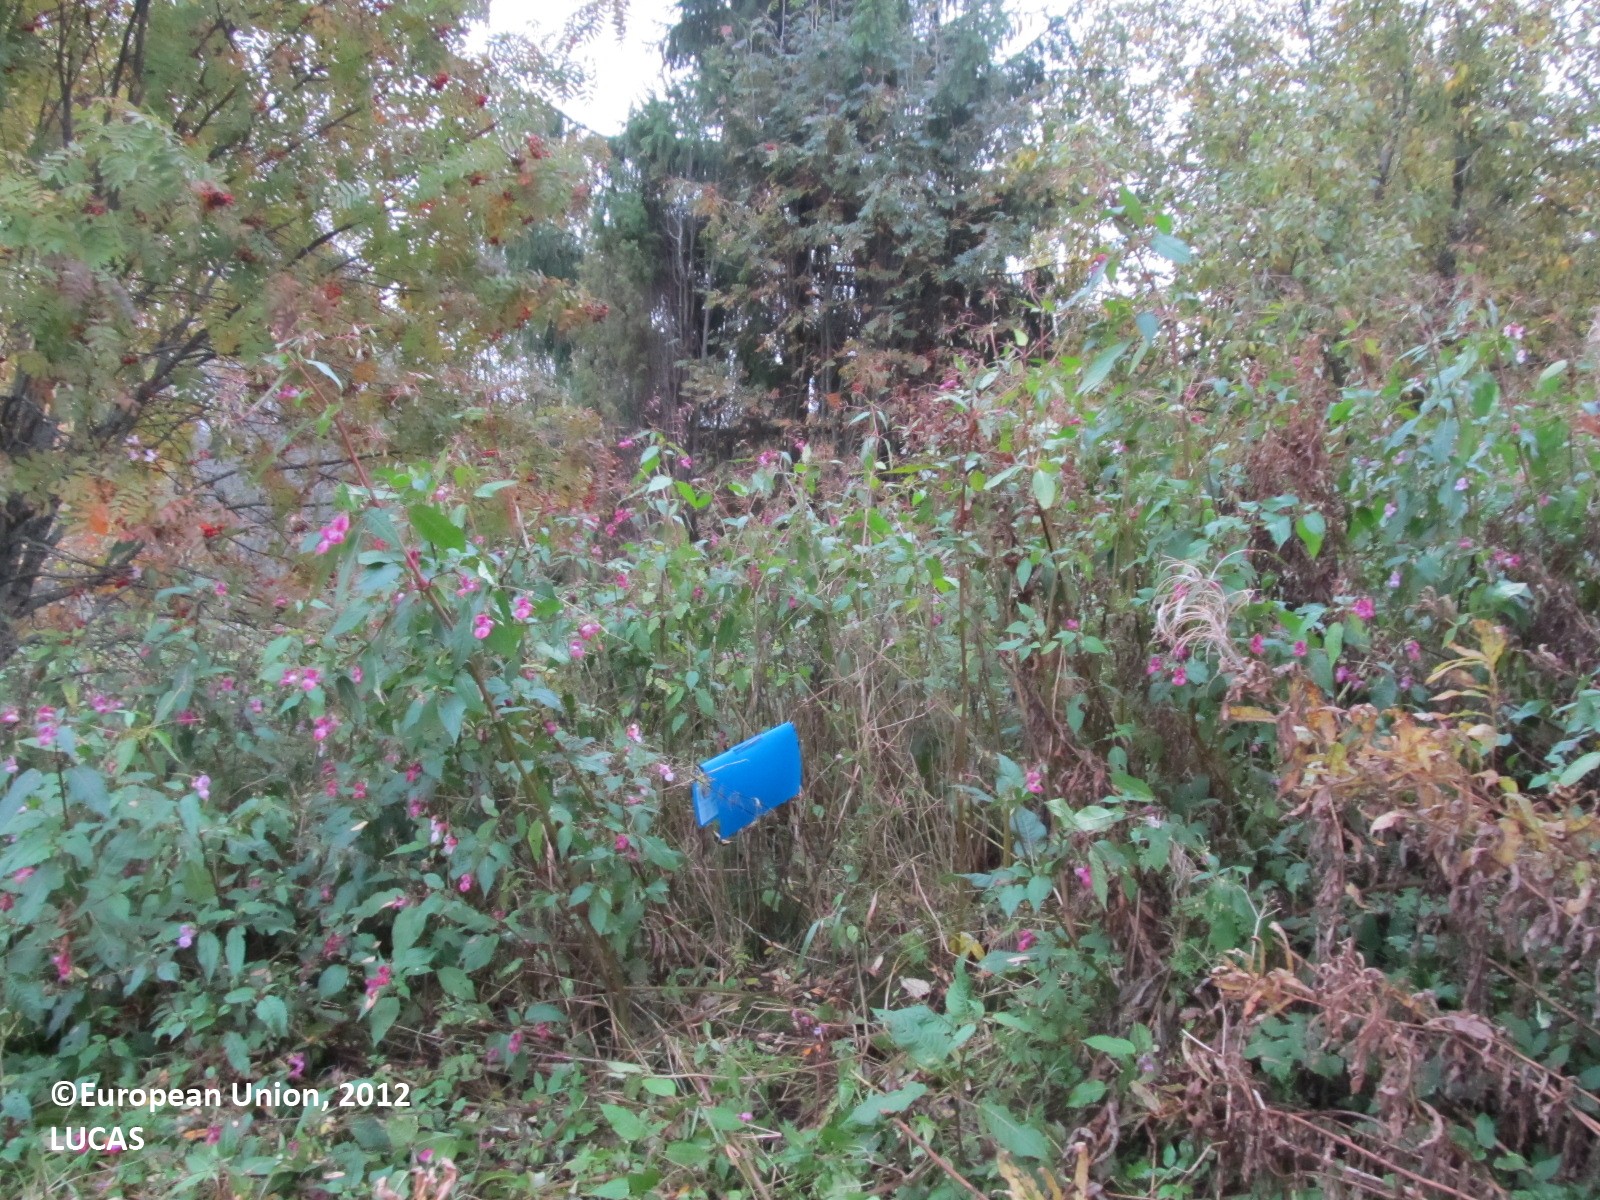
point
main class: Shrubland
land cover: Shrubland with sparse tree cover
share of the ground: > 75 %
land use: Semi-natural and natural areas not in use
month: September
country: FI
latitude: 62.2600
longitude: 28.1197
